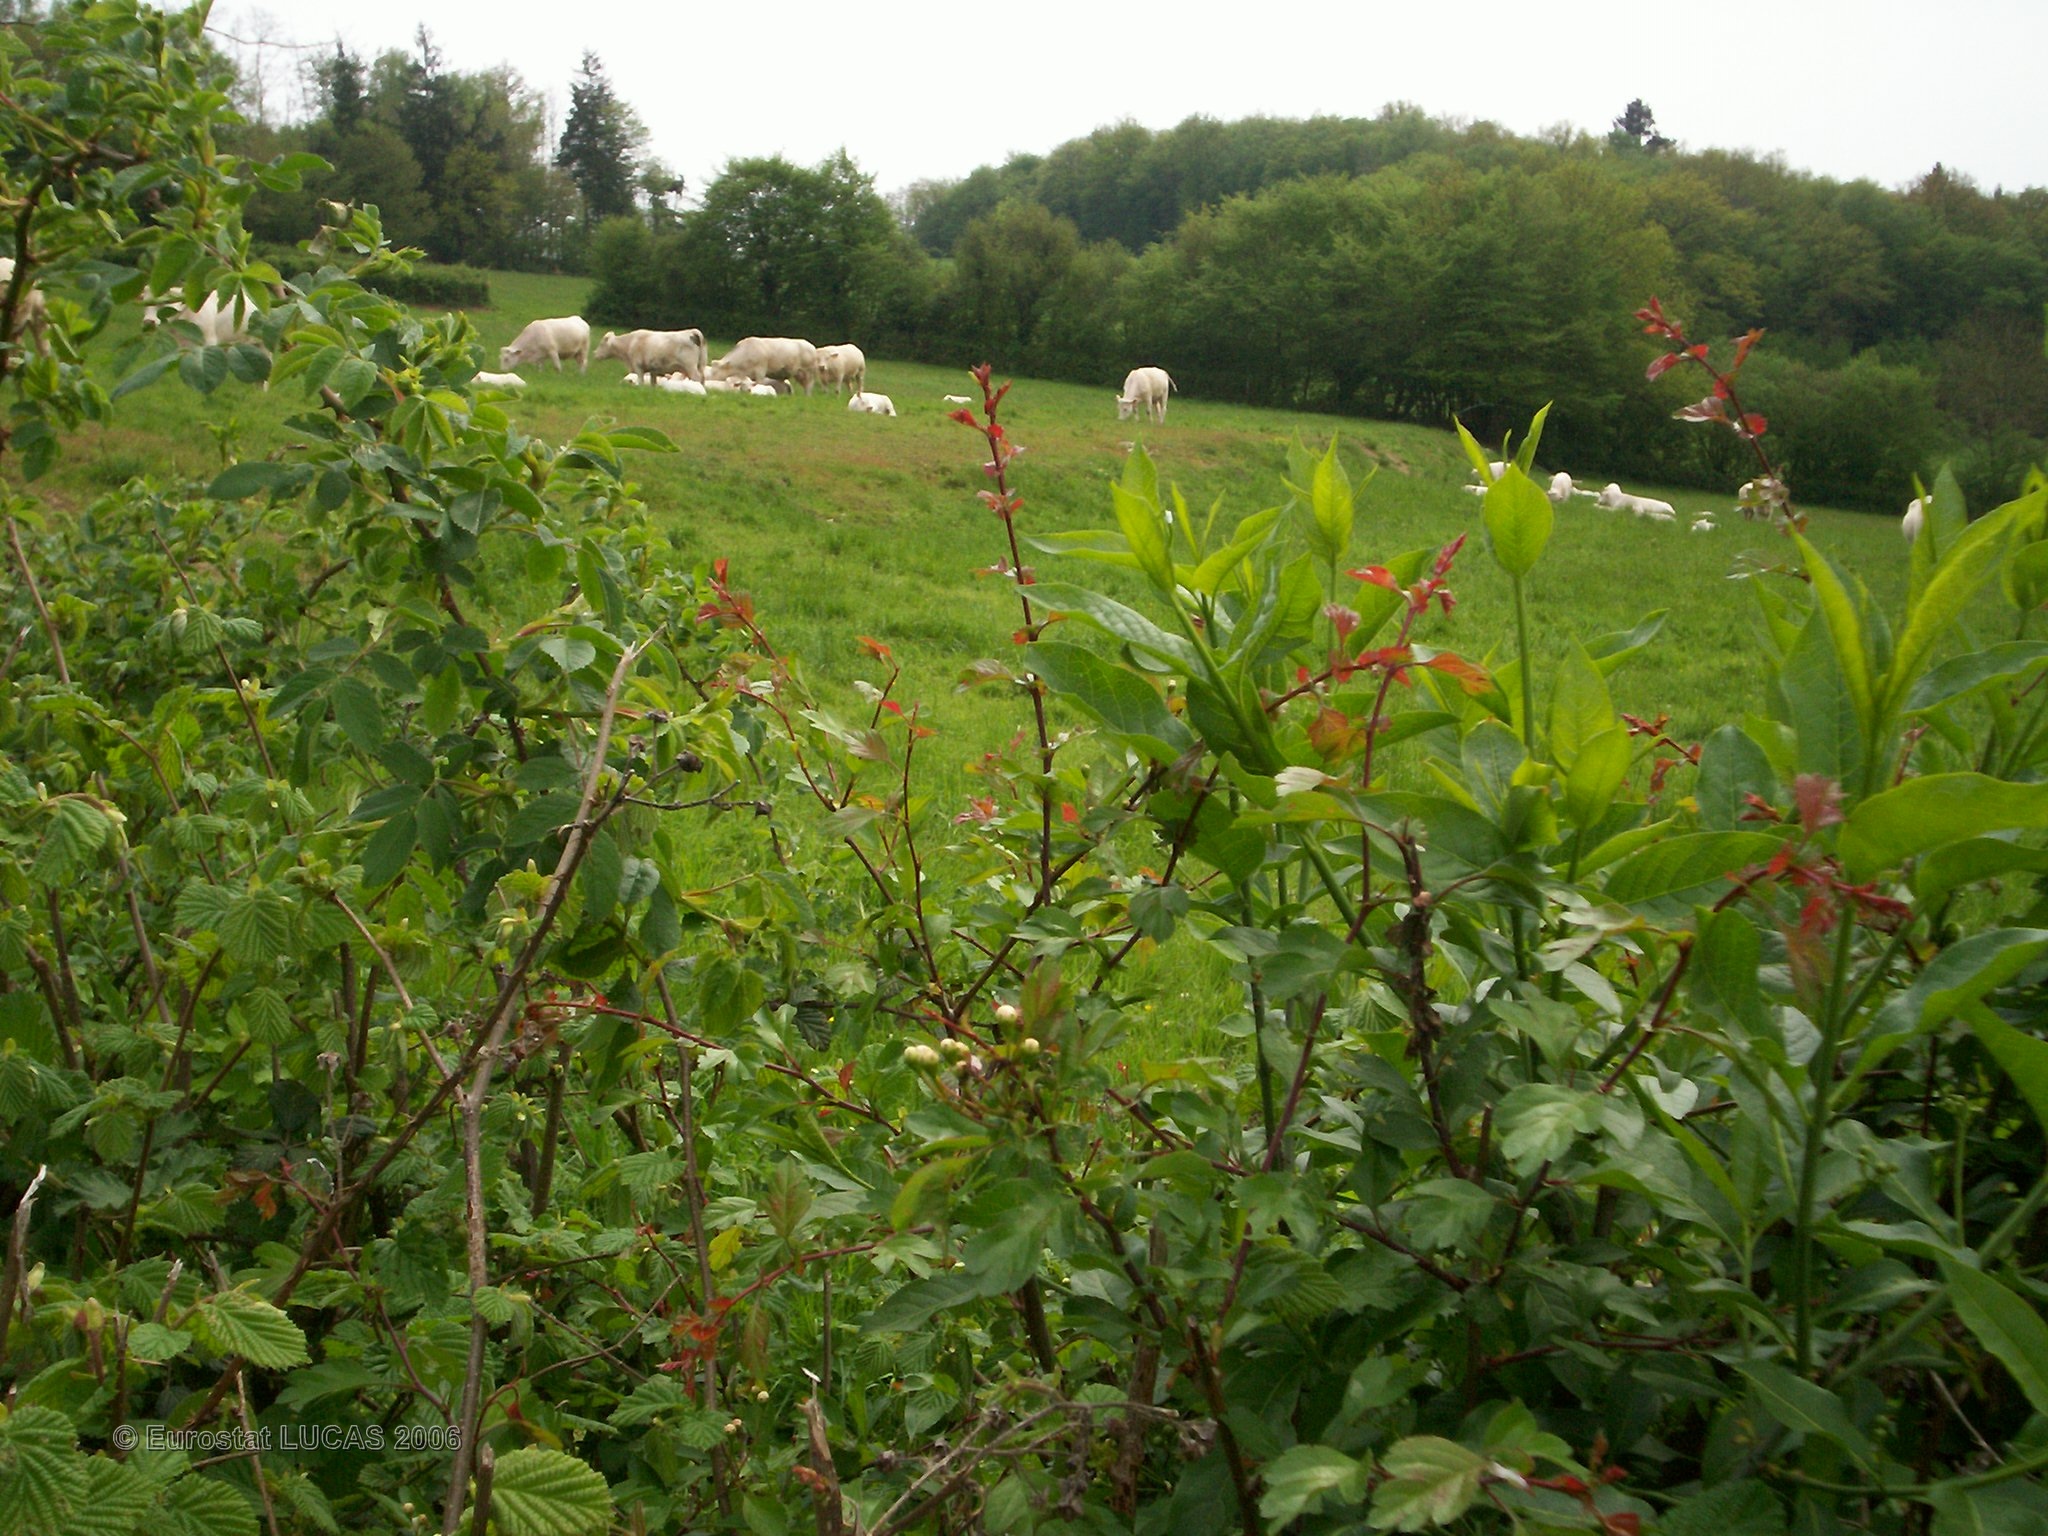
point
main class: Grassland
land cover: Grassland without tree/shrub cover
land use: Agriculture (excluding fallow land and kitchen gardens)
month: May
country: FR
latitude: 47.4043
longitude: 3.8889
